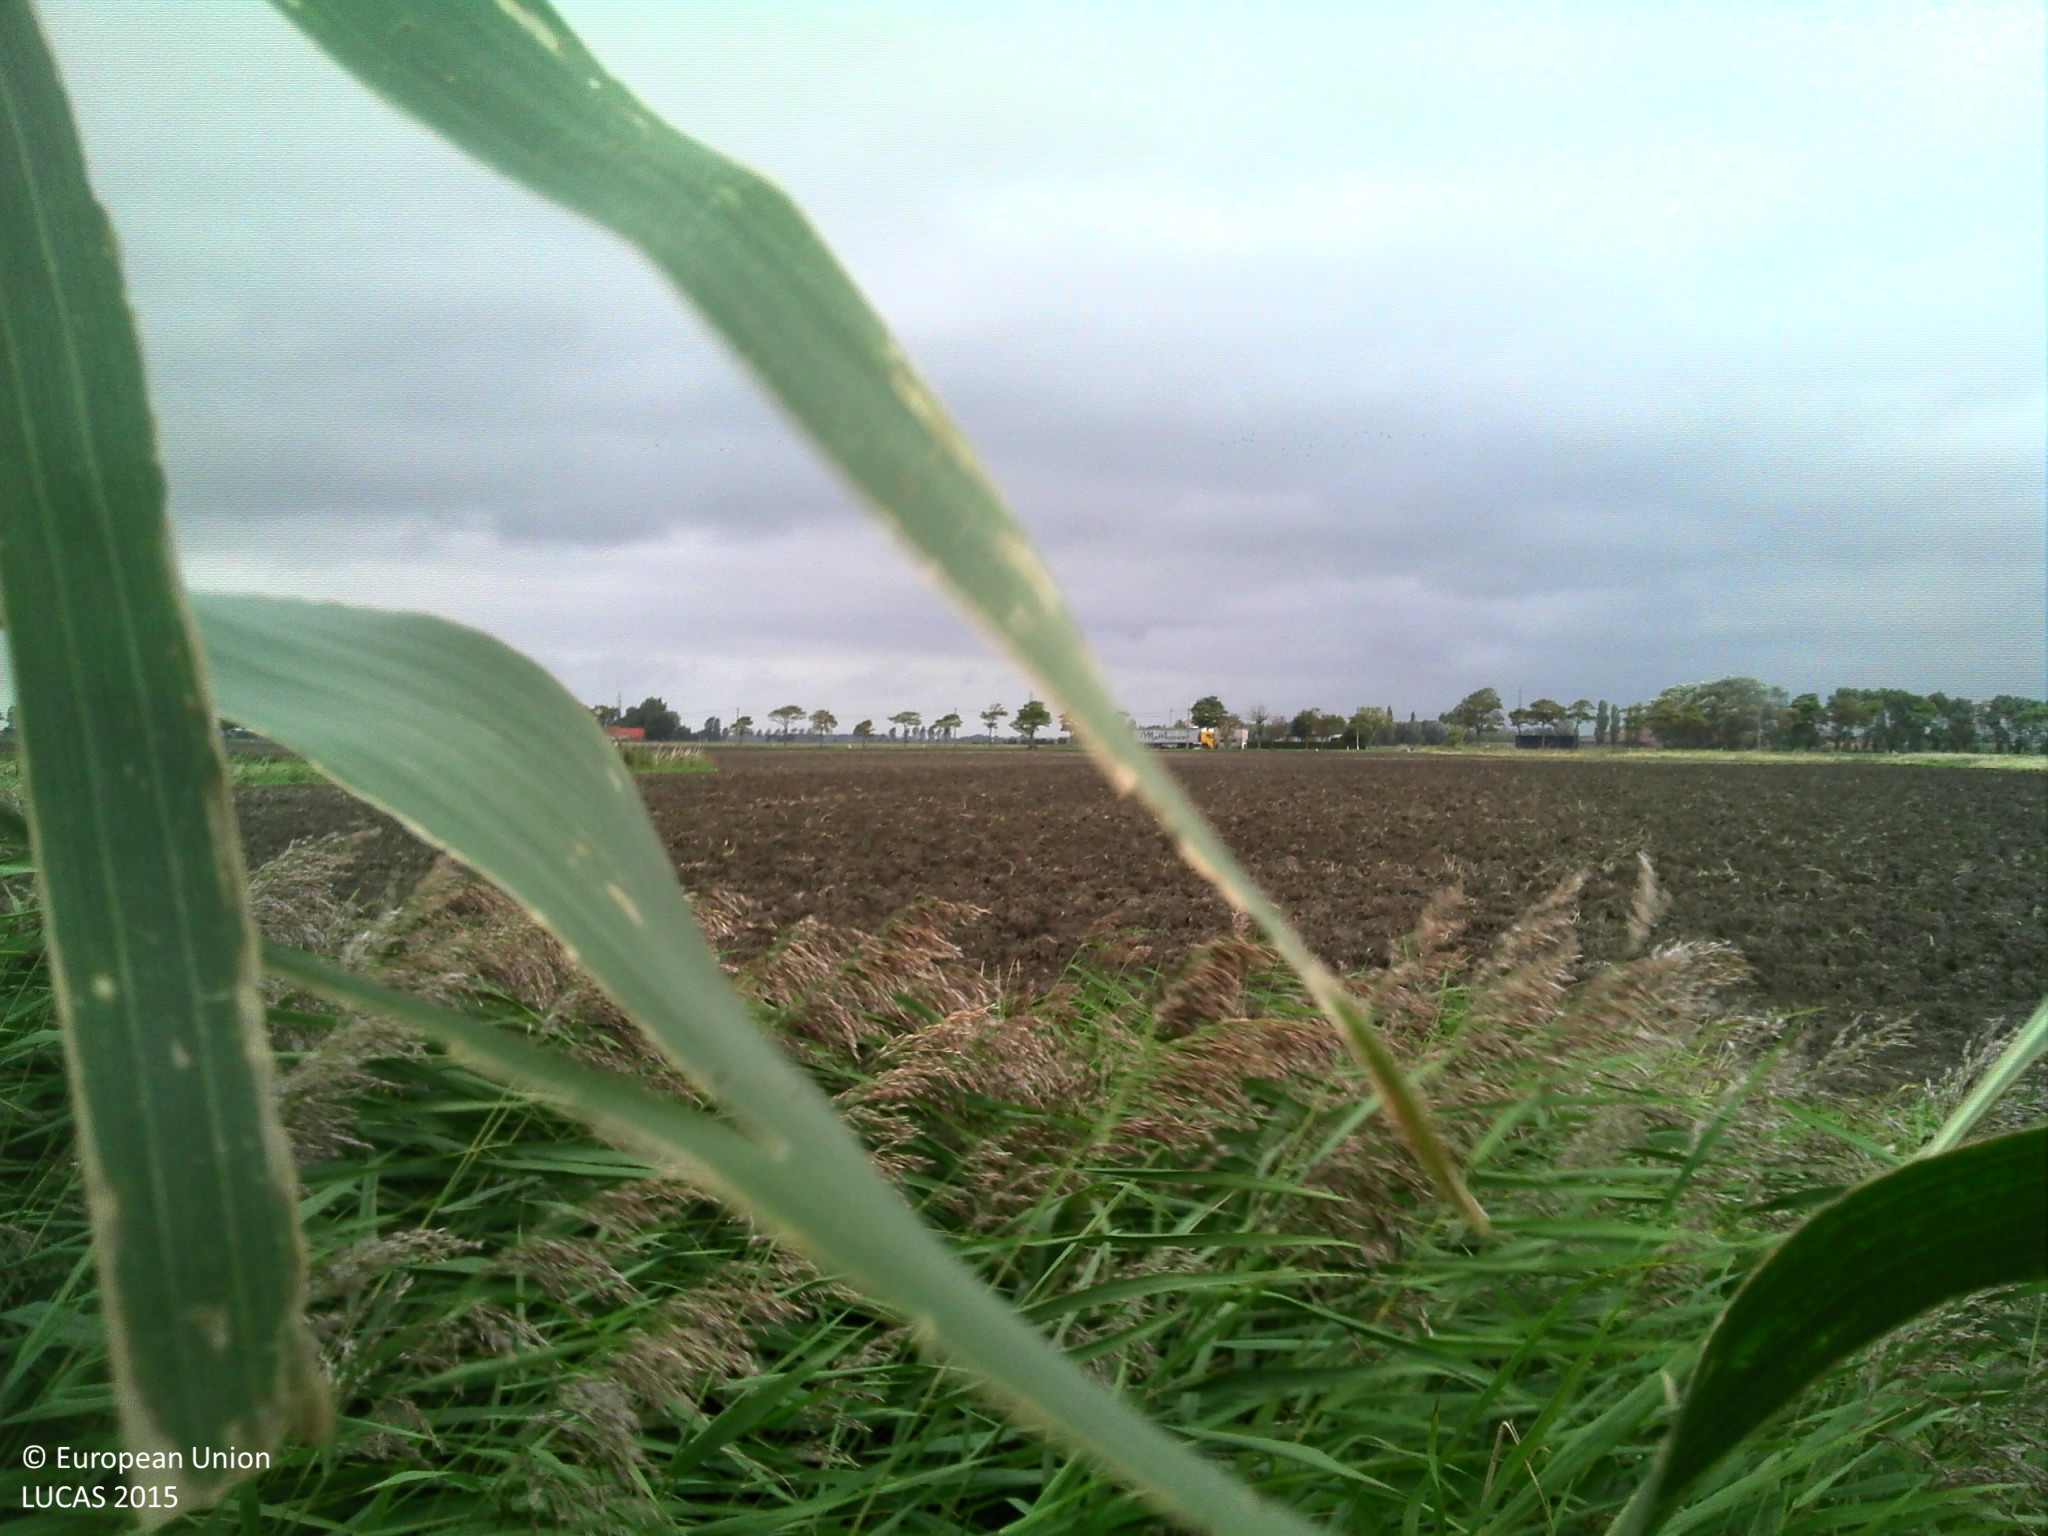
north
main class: Cropland
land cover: Maize
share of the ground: > 75 %
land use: Agriculture (excluding fallow land and kitchen gardens)
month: September
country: BE
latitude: 51.0728
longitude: 2.7526
